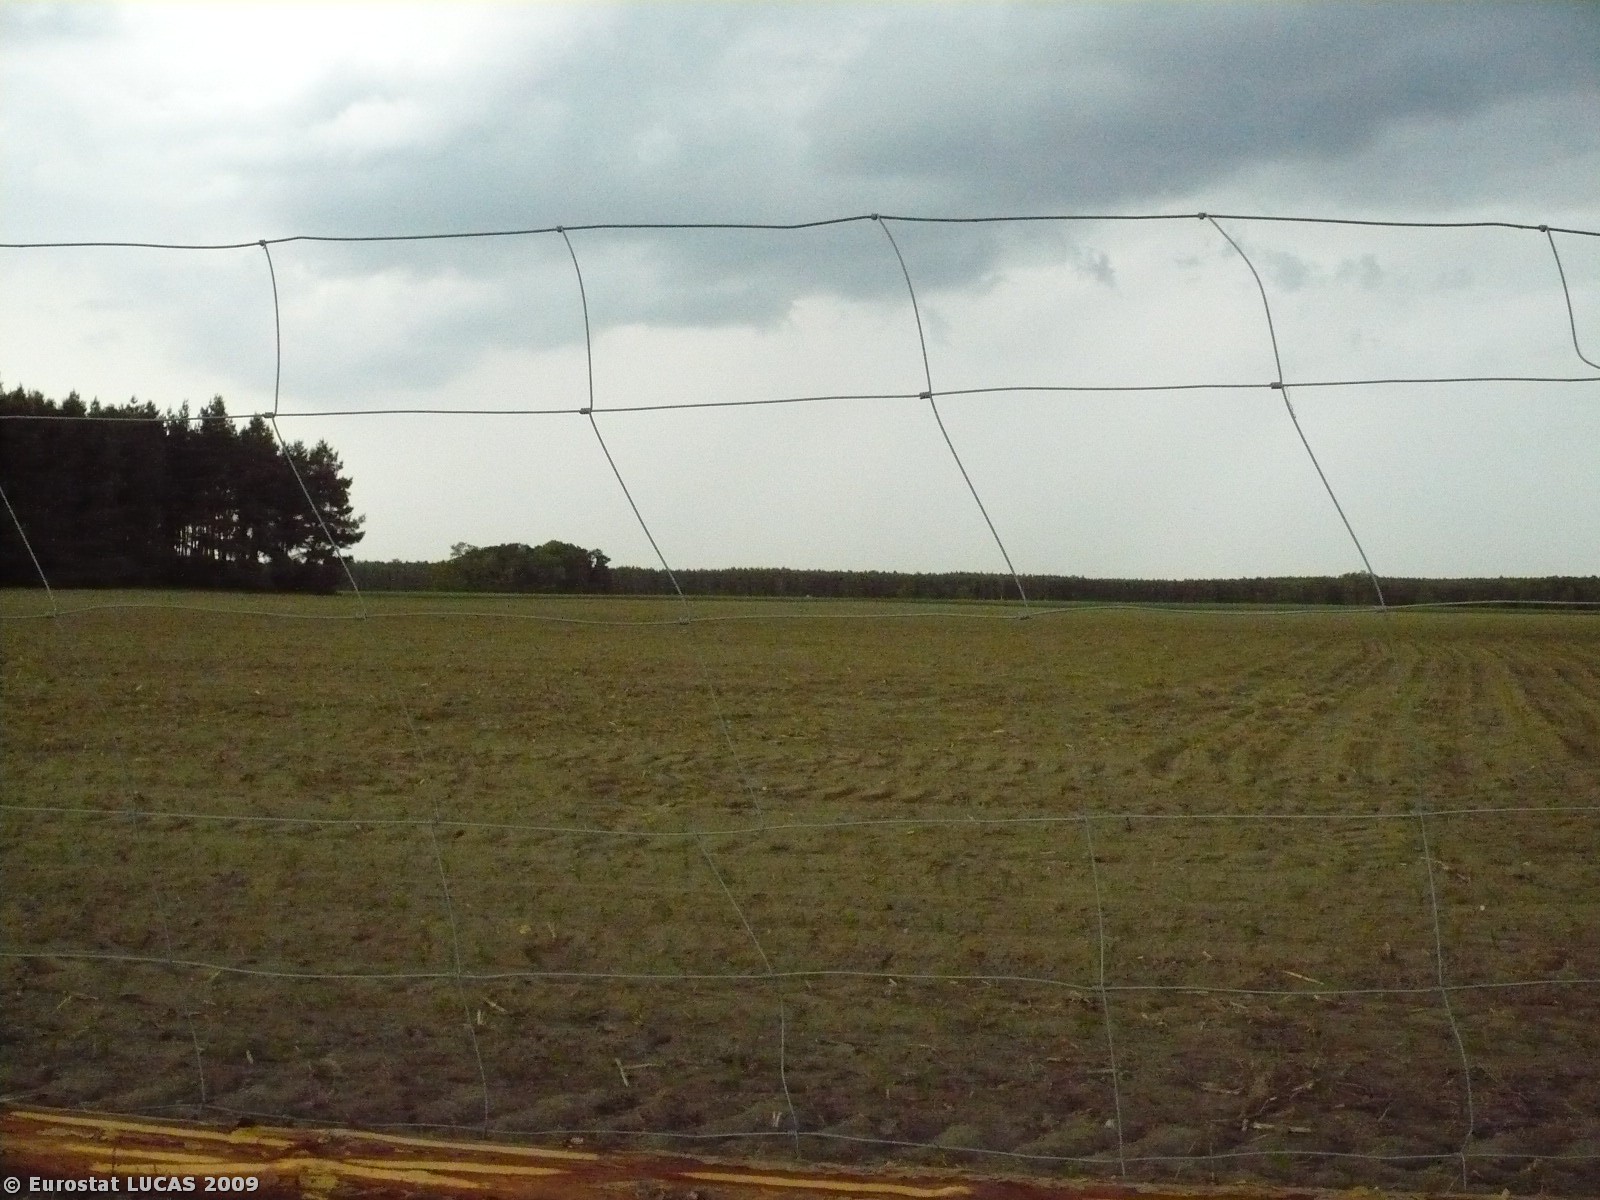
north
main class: Cropland
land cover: Maize
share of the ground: < 10 %
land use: Agriculture (excluding fallow land and kitchen gardens)
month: May
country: PL
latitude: 52.1315
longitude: 15.3358
